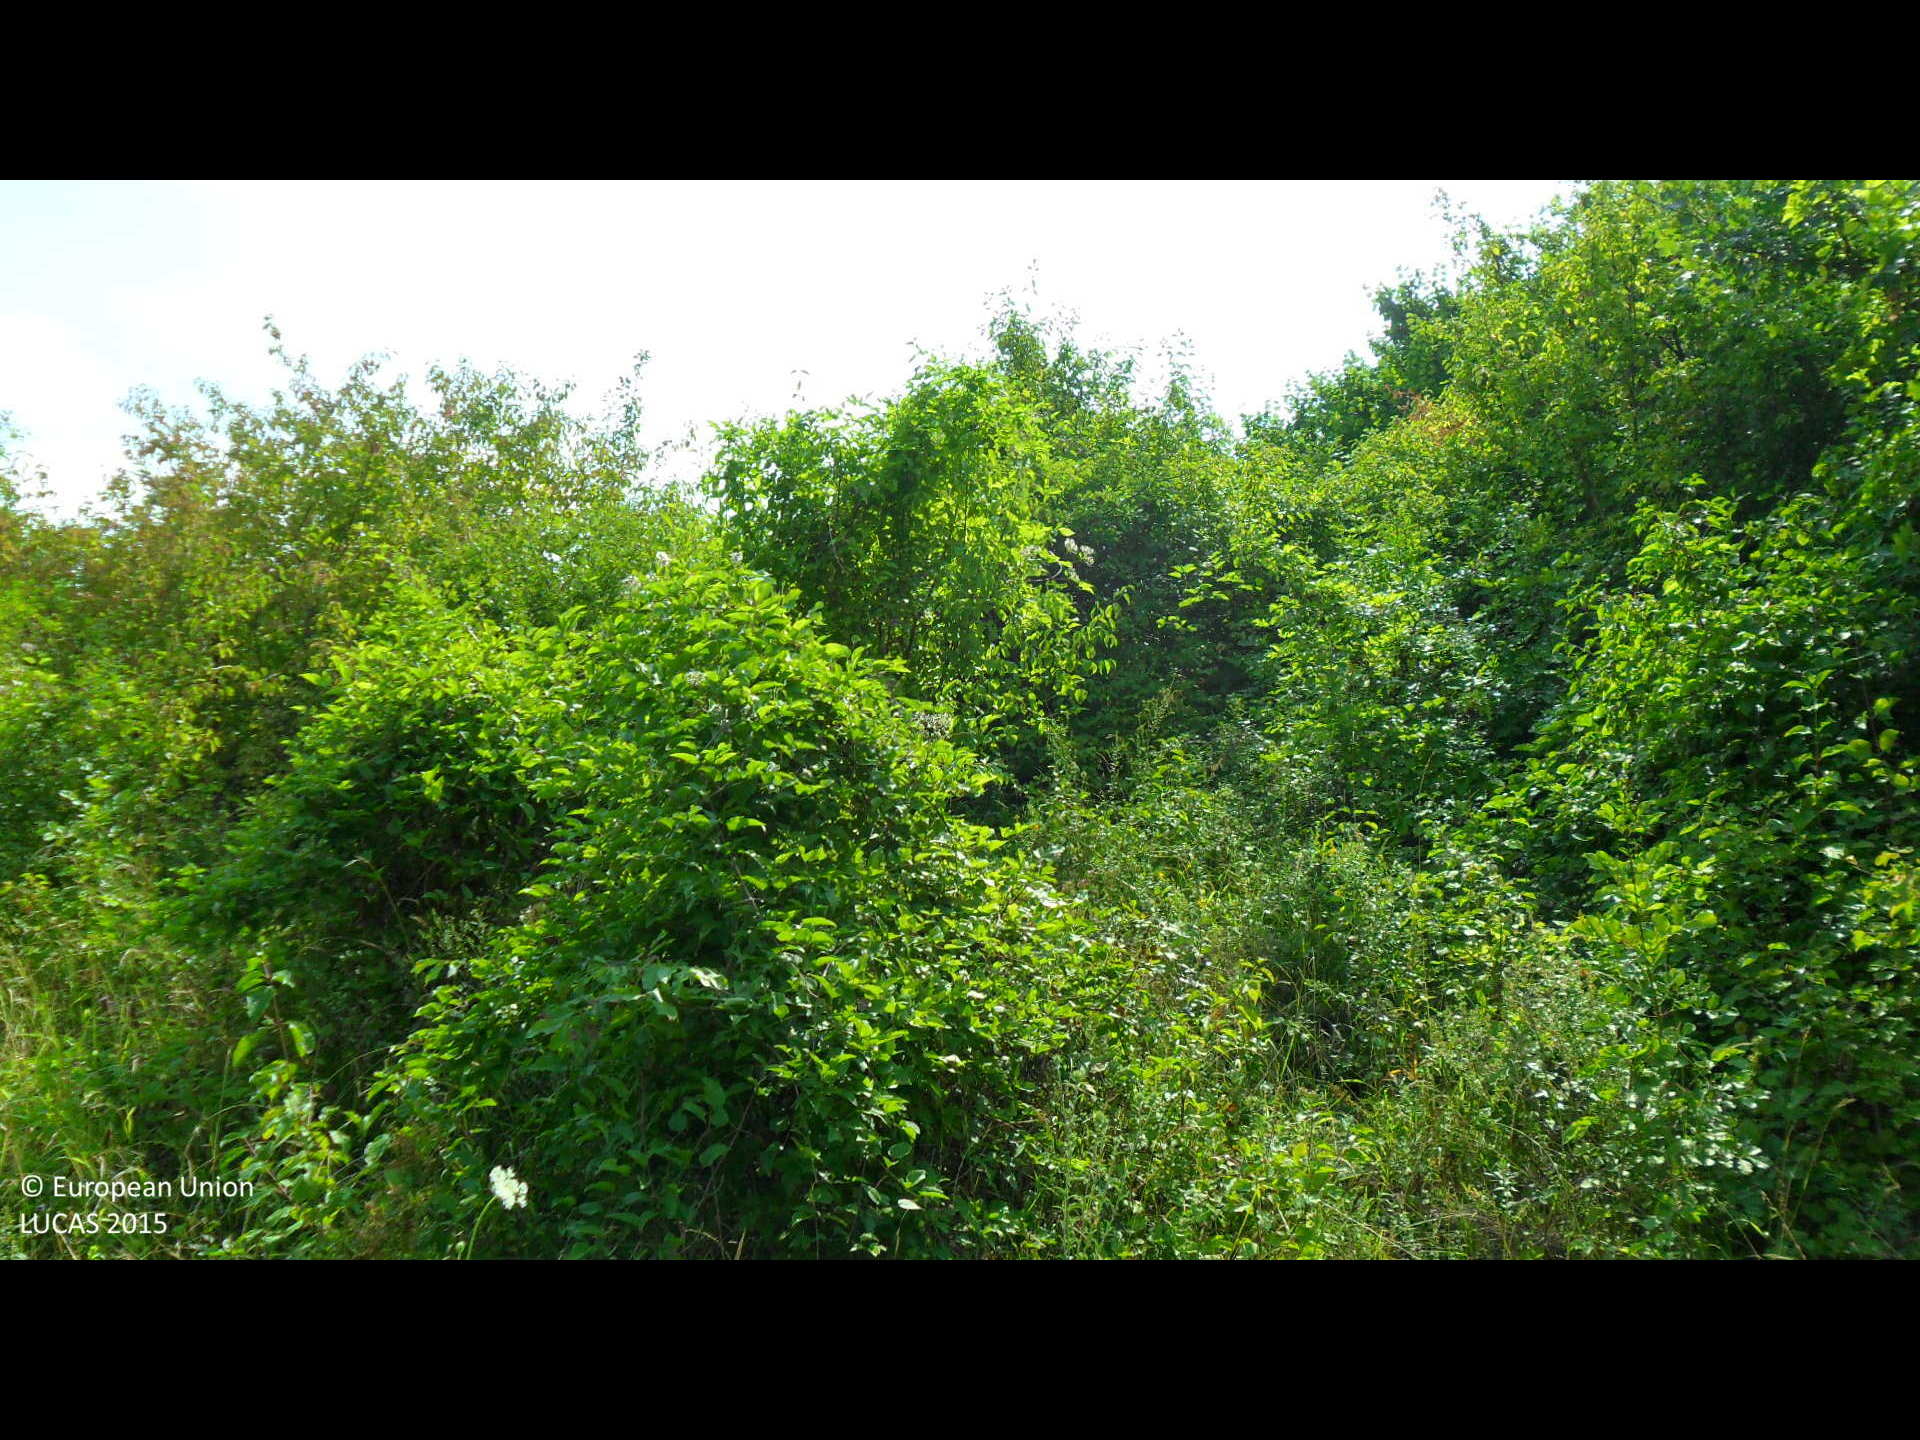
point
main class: Woodland
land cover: Broadleaved woodland
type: mesophytic deciduous forest
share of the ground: > 75 %
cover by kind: broadleaved forest trees 90 %, shrubs 10 %
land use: Forestry
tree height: > 5 m
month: July
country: BG
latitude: 43.3596
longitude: 26.3244
